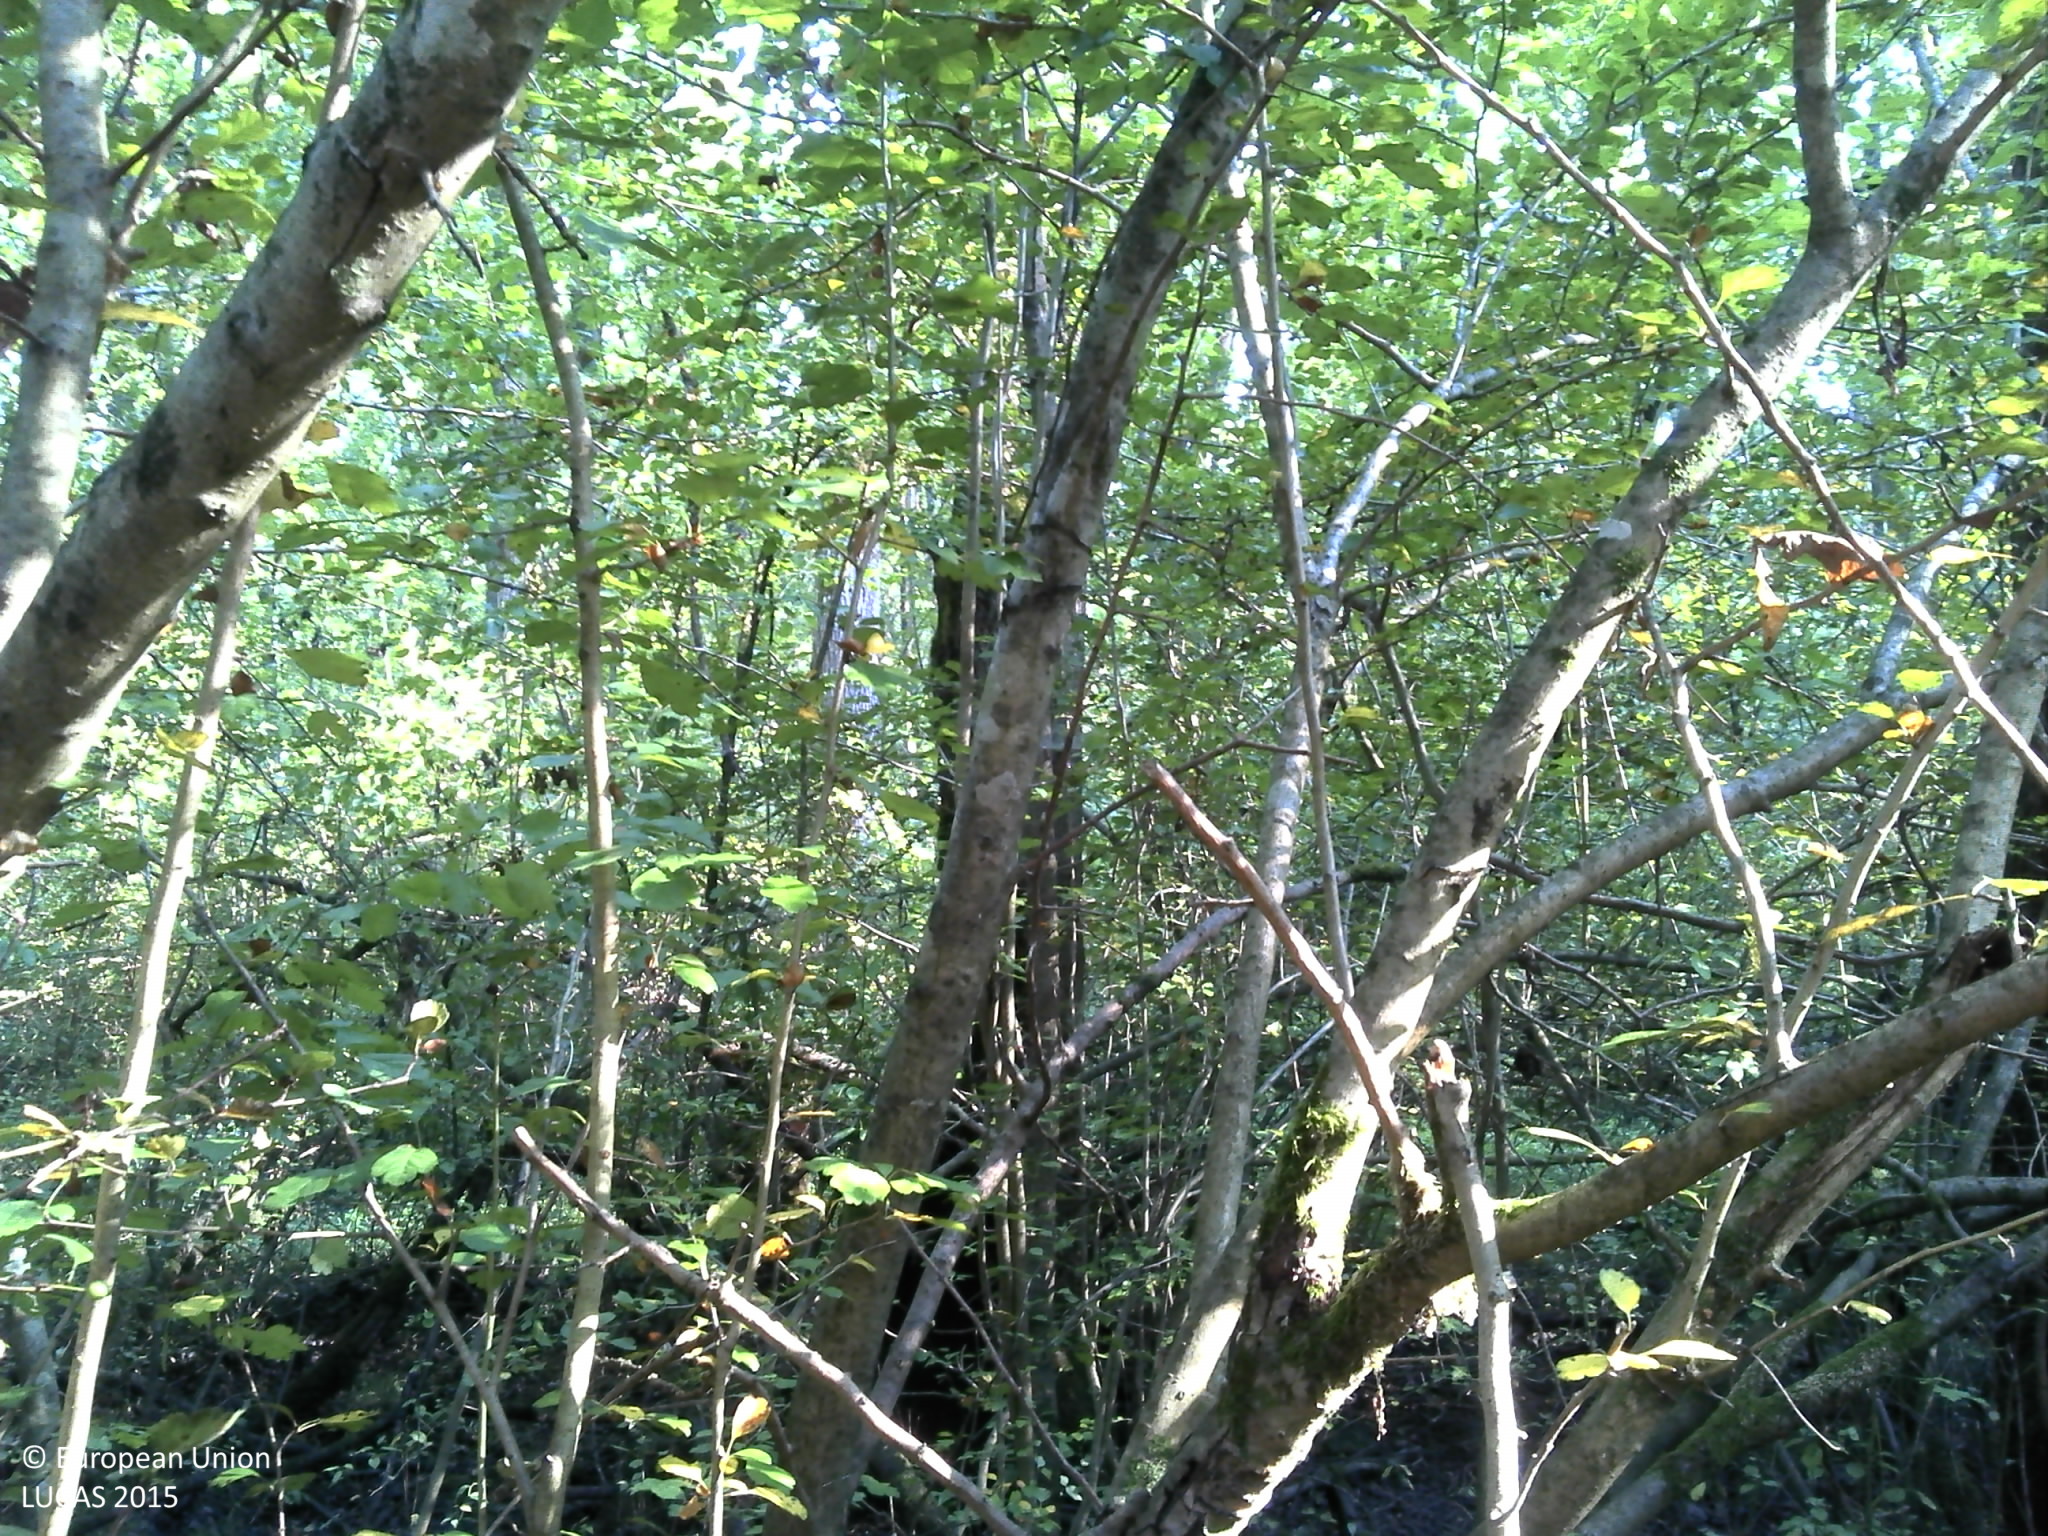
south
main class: Woodland
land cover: Broadleaved woodland
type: acidophilous oak and oak-birch forest
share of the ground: > 75 %
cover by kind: broadleaved forest trees 100 %
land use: Forestry
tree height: > 5 m
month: August
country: HR
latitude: 45.5519
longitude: 16.2873
